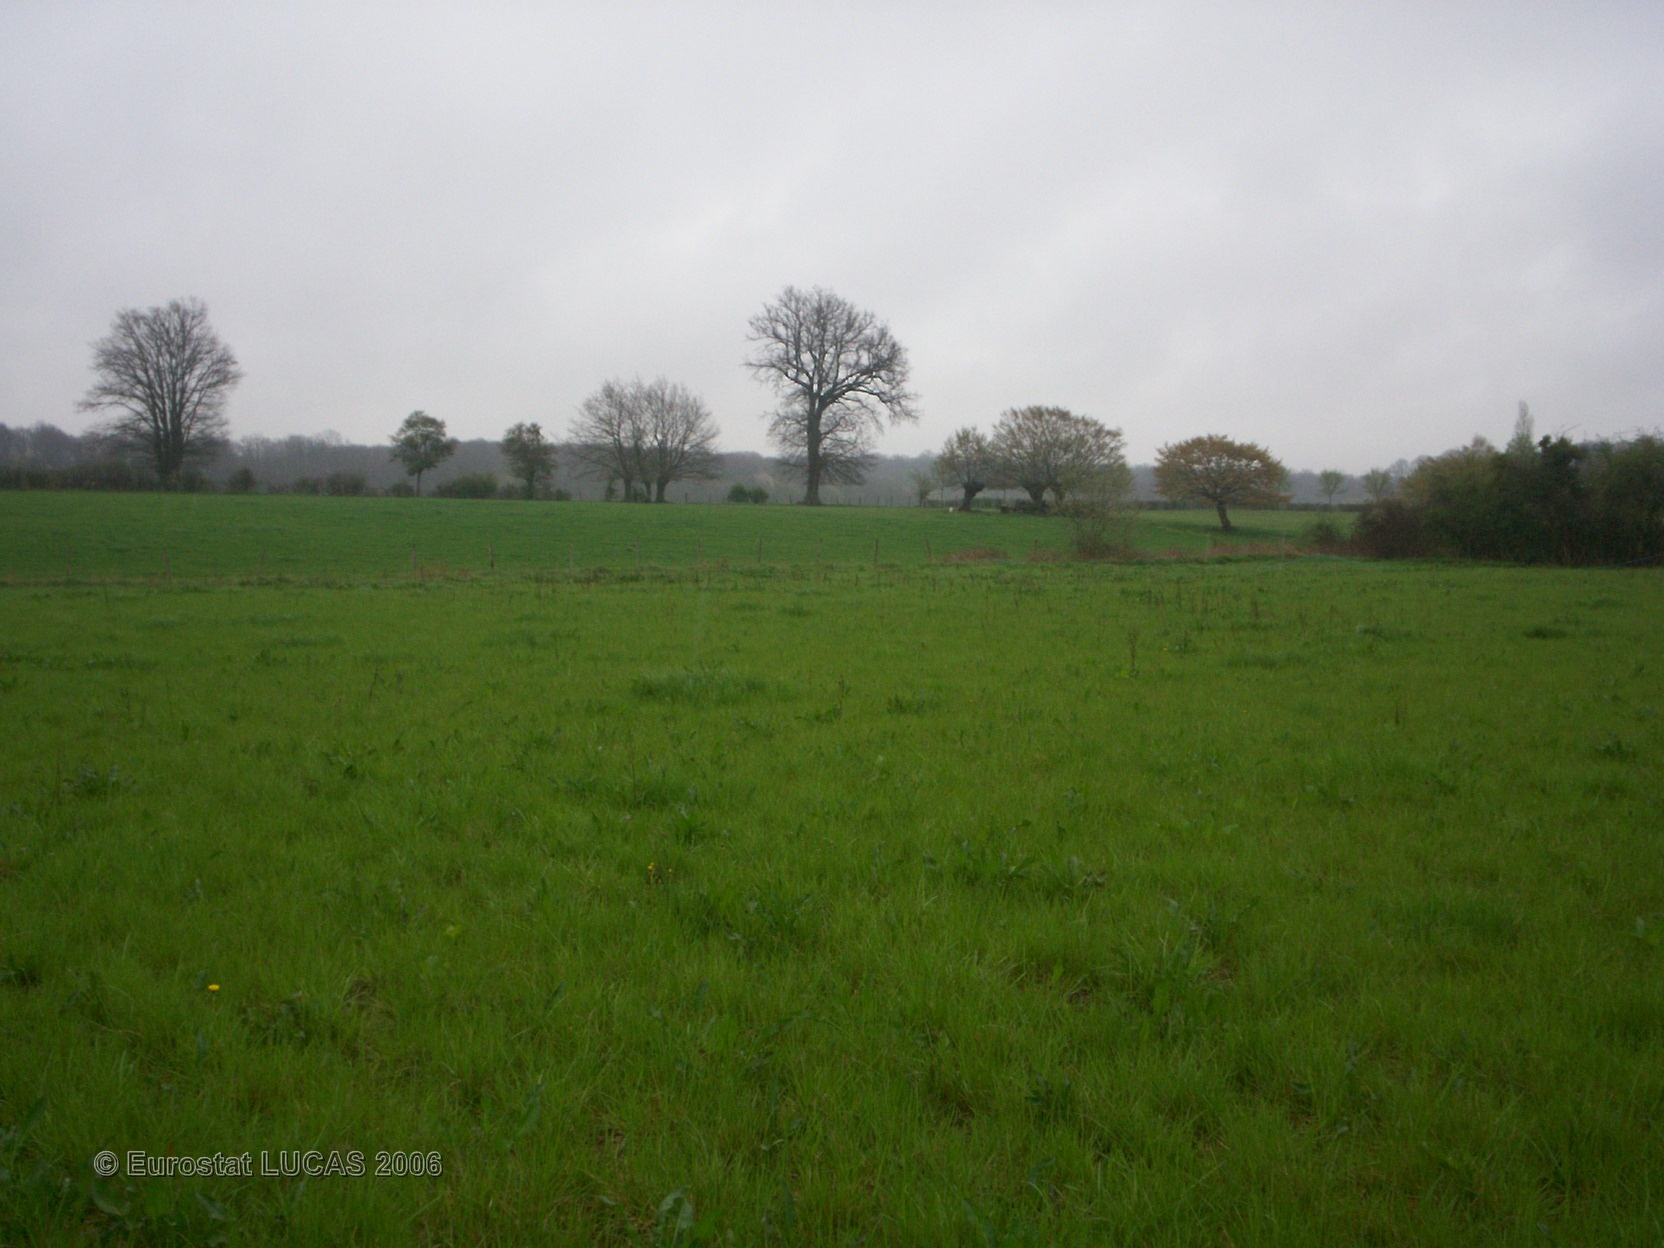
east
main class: Grassland
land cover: Grassland without tree/shrub cover
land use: Agriculture (excluding fallow land and kitchen gardens)
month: April
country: FR
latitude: 47.5275
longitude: 2.9411
